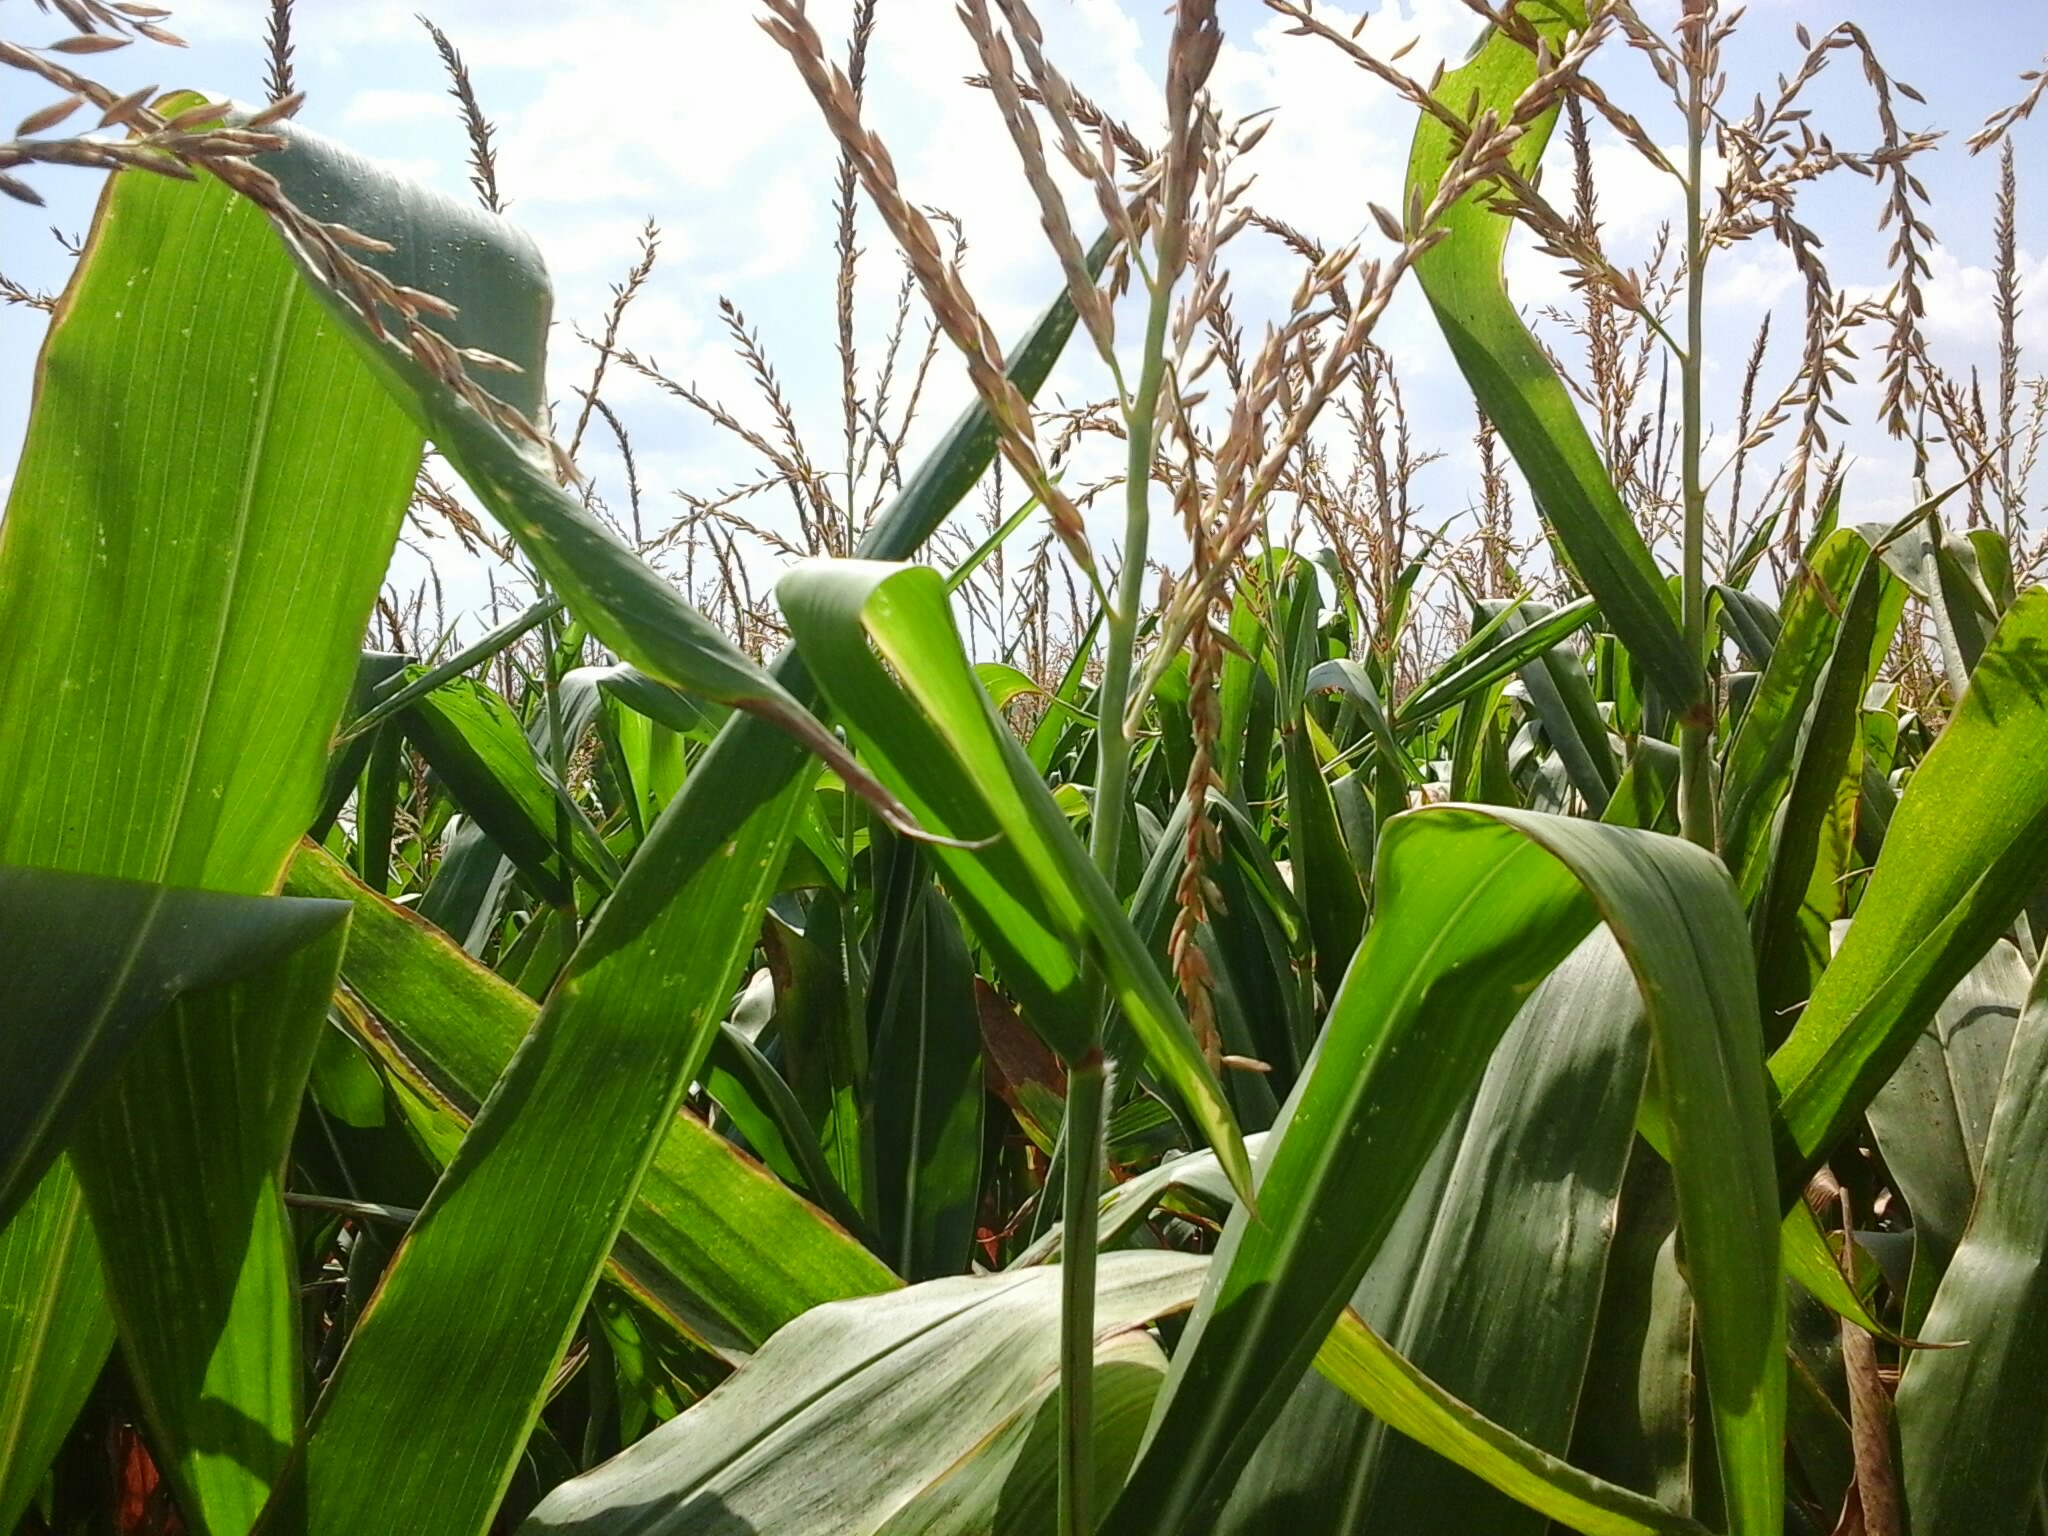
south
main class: Cropland
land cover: Maize
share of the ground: > 75 %
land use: Agriculture (excluding fallow land and kitchen gardens)
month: August
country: HU
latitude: 47.5689
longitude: 18.0265
